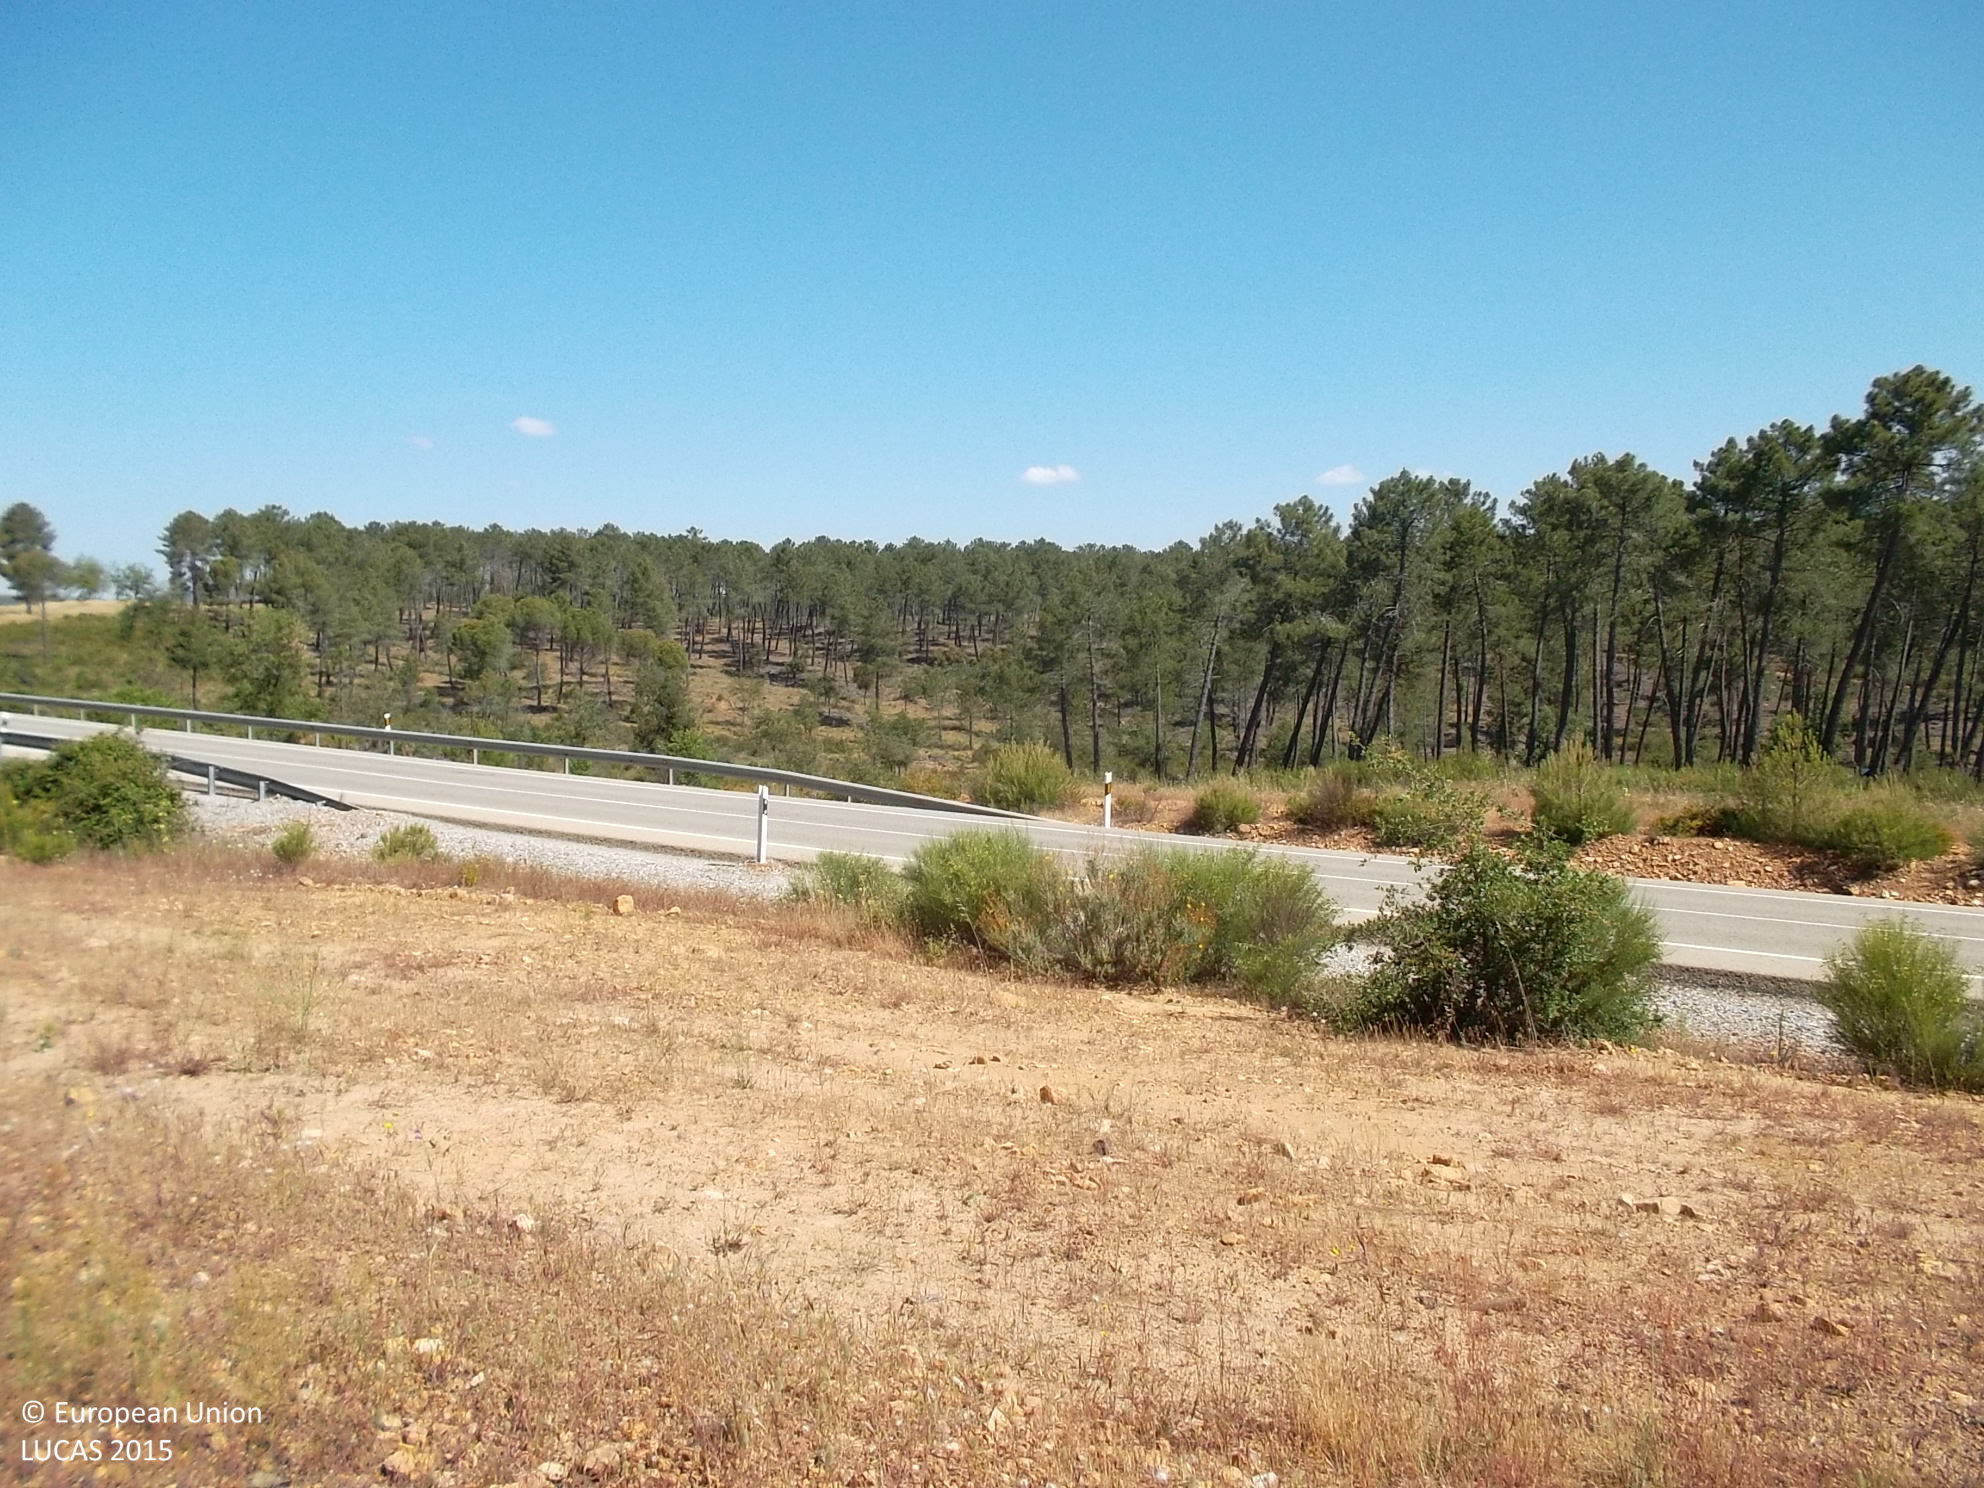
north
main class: Grassland
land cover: Grassland without tree/shrub cover
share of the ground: 50 - 75 %
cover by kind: herbaceous plants 75 %, unconsolidated bare surface 20 %, shrubs 5 %
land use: Protection infrastructures
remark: Fire break
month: May
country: ES
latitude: 38.4711
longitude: -4.3569
